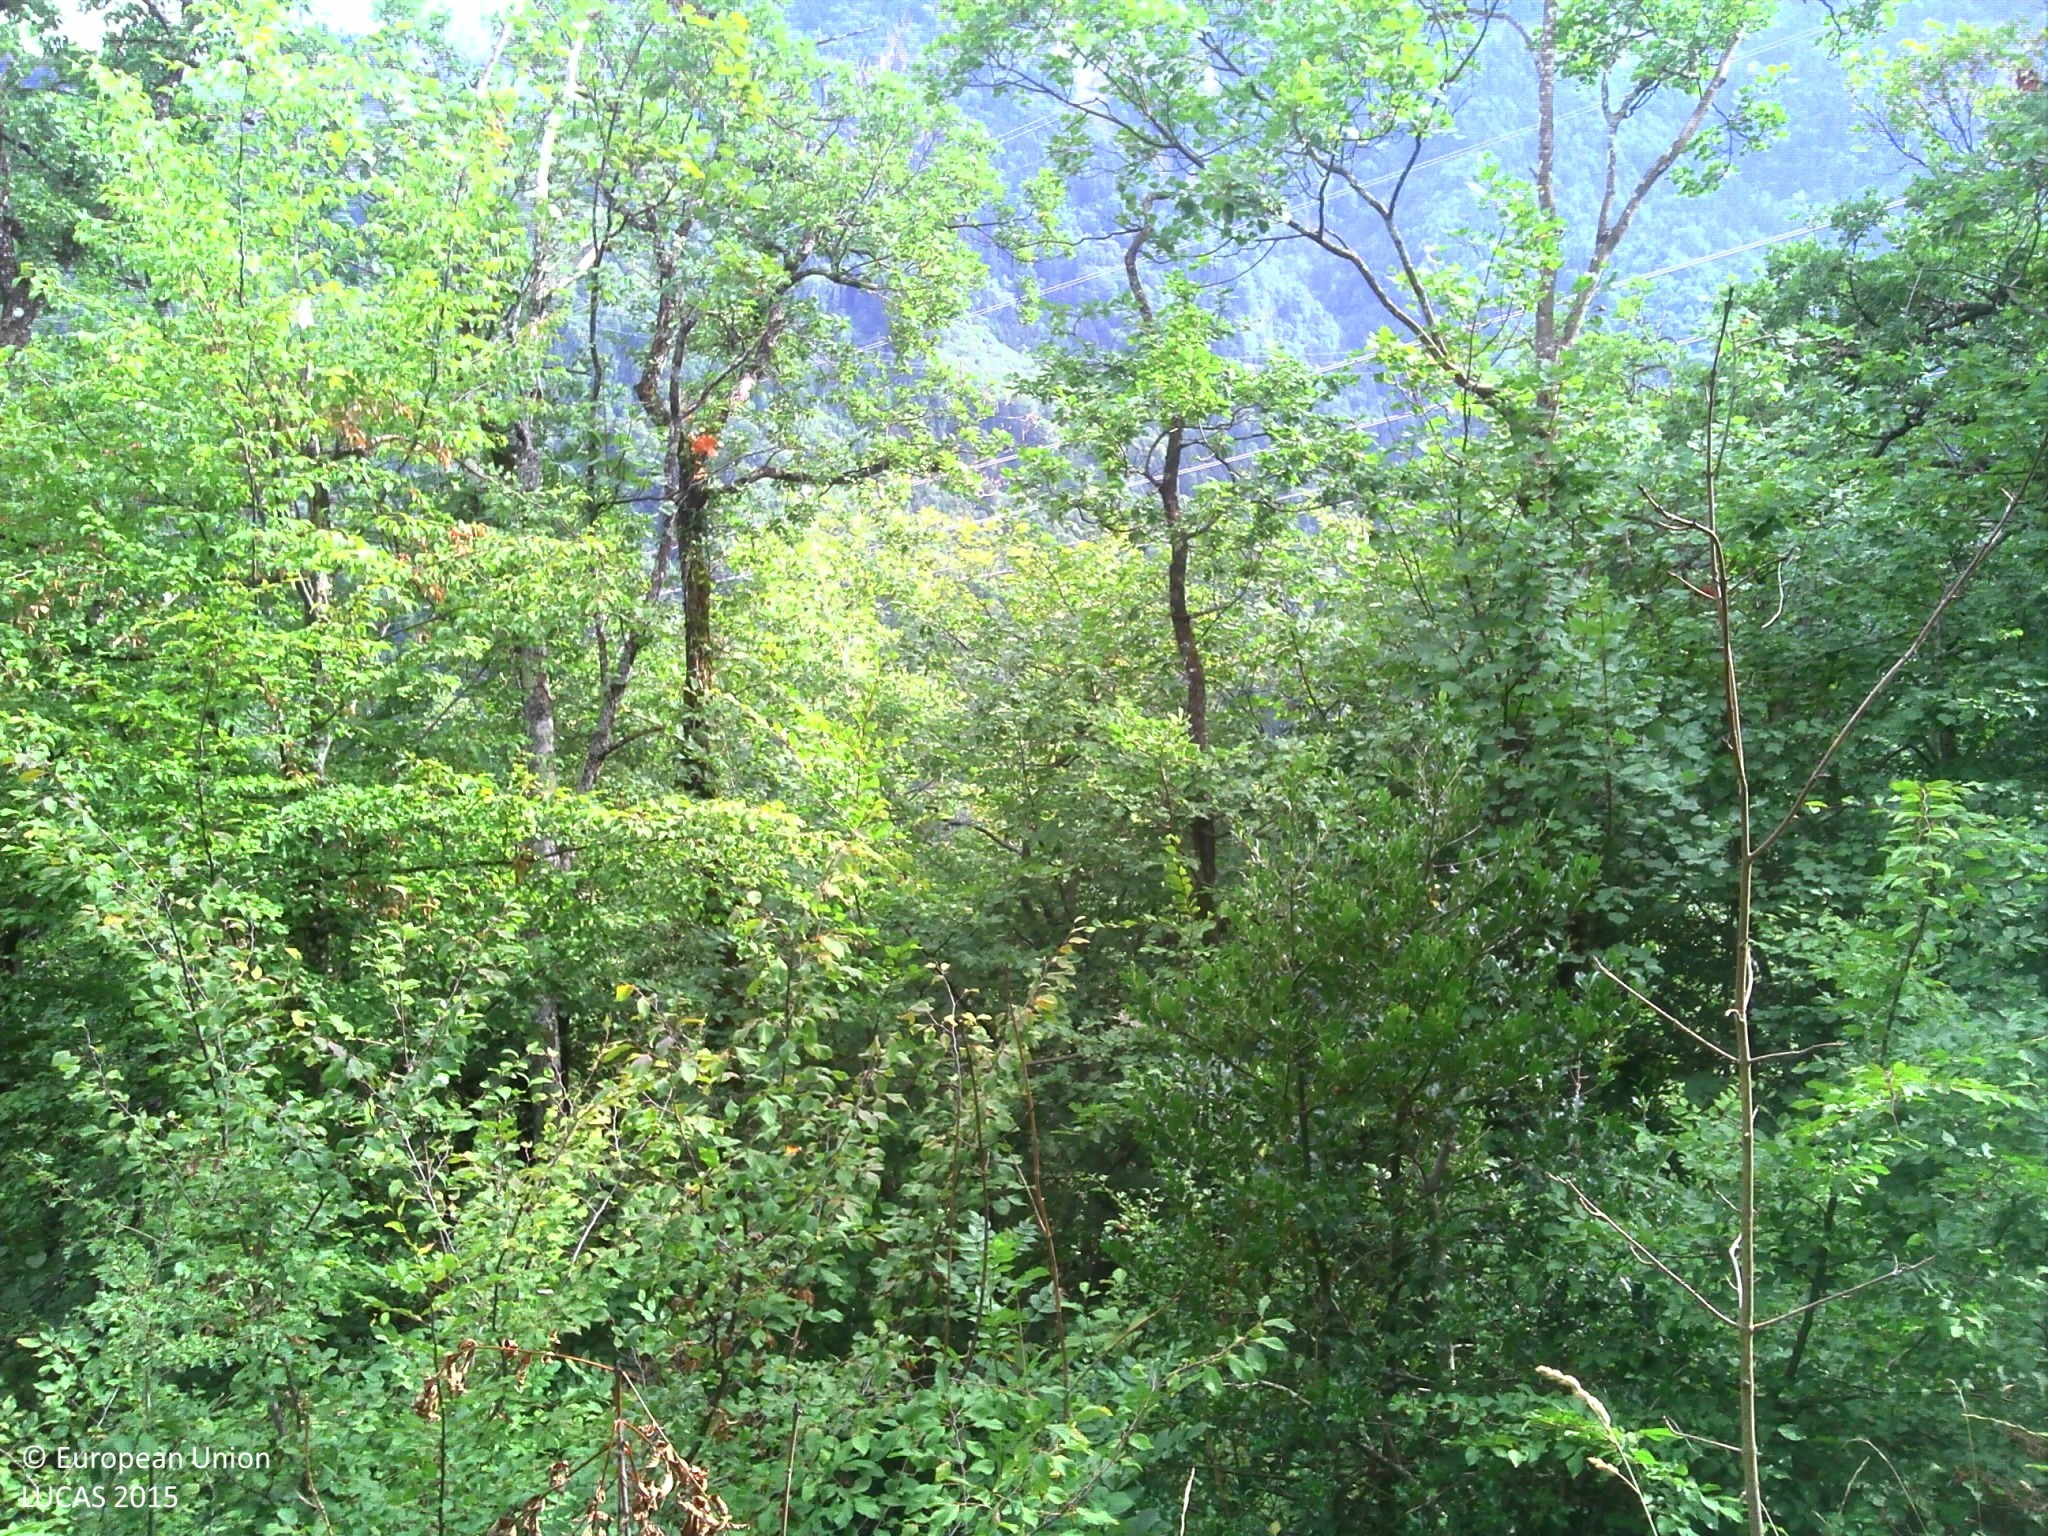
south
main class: Woodland
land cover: Broadleaved woodland
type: mesophytic deciduous forest
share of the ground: > 75 %
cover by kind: broadleaved forest trees 80 %, unconsolidated bare surface 10 %, coniferous forest trees 5 %, lichens and mosses 5 %
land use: Forestry
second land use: Sport
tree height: > 5 m
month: August
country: FR
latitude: 45.2676
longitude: 5.5826
